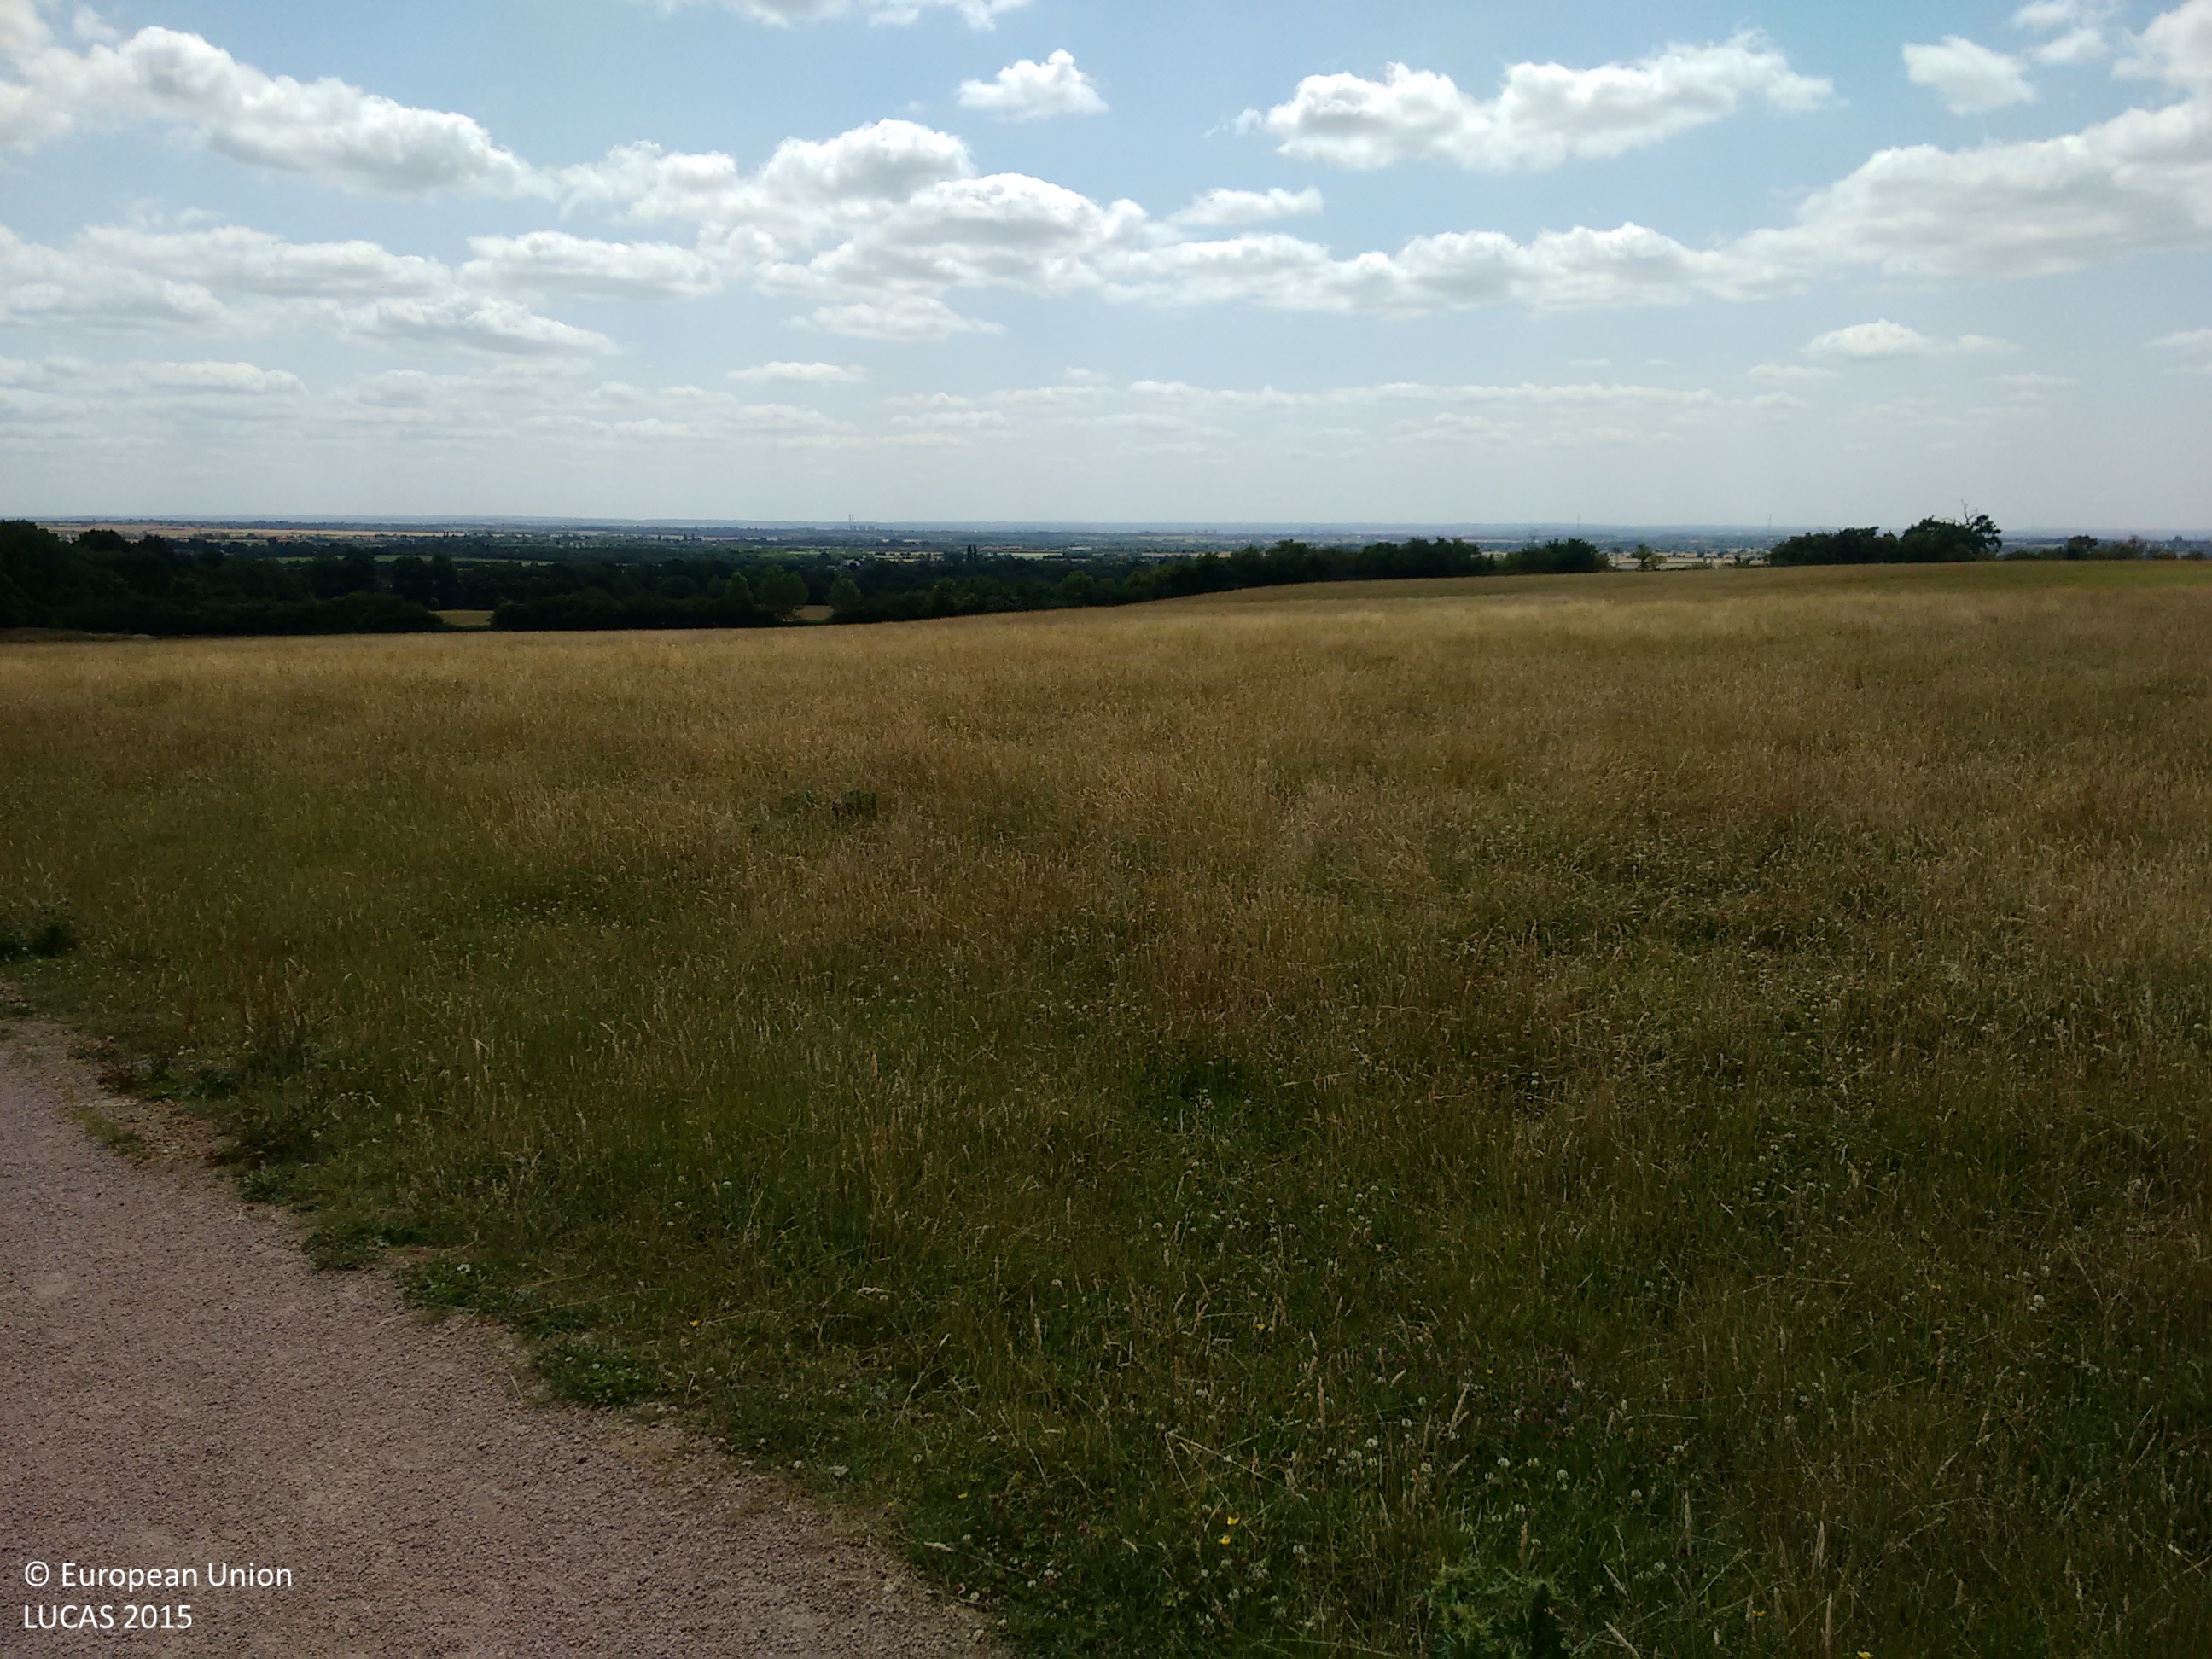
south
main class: Grassland
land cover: Grassland without tree/shrub cover
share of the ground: > 75 %
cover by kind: herbaceous plants 100 %
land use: Agriculture (excluding fallow land and kitchen gardens)
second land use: Amenities, museums, leisure
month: July
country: GB
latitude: 51.5846
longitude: 0.3443
